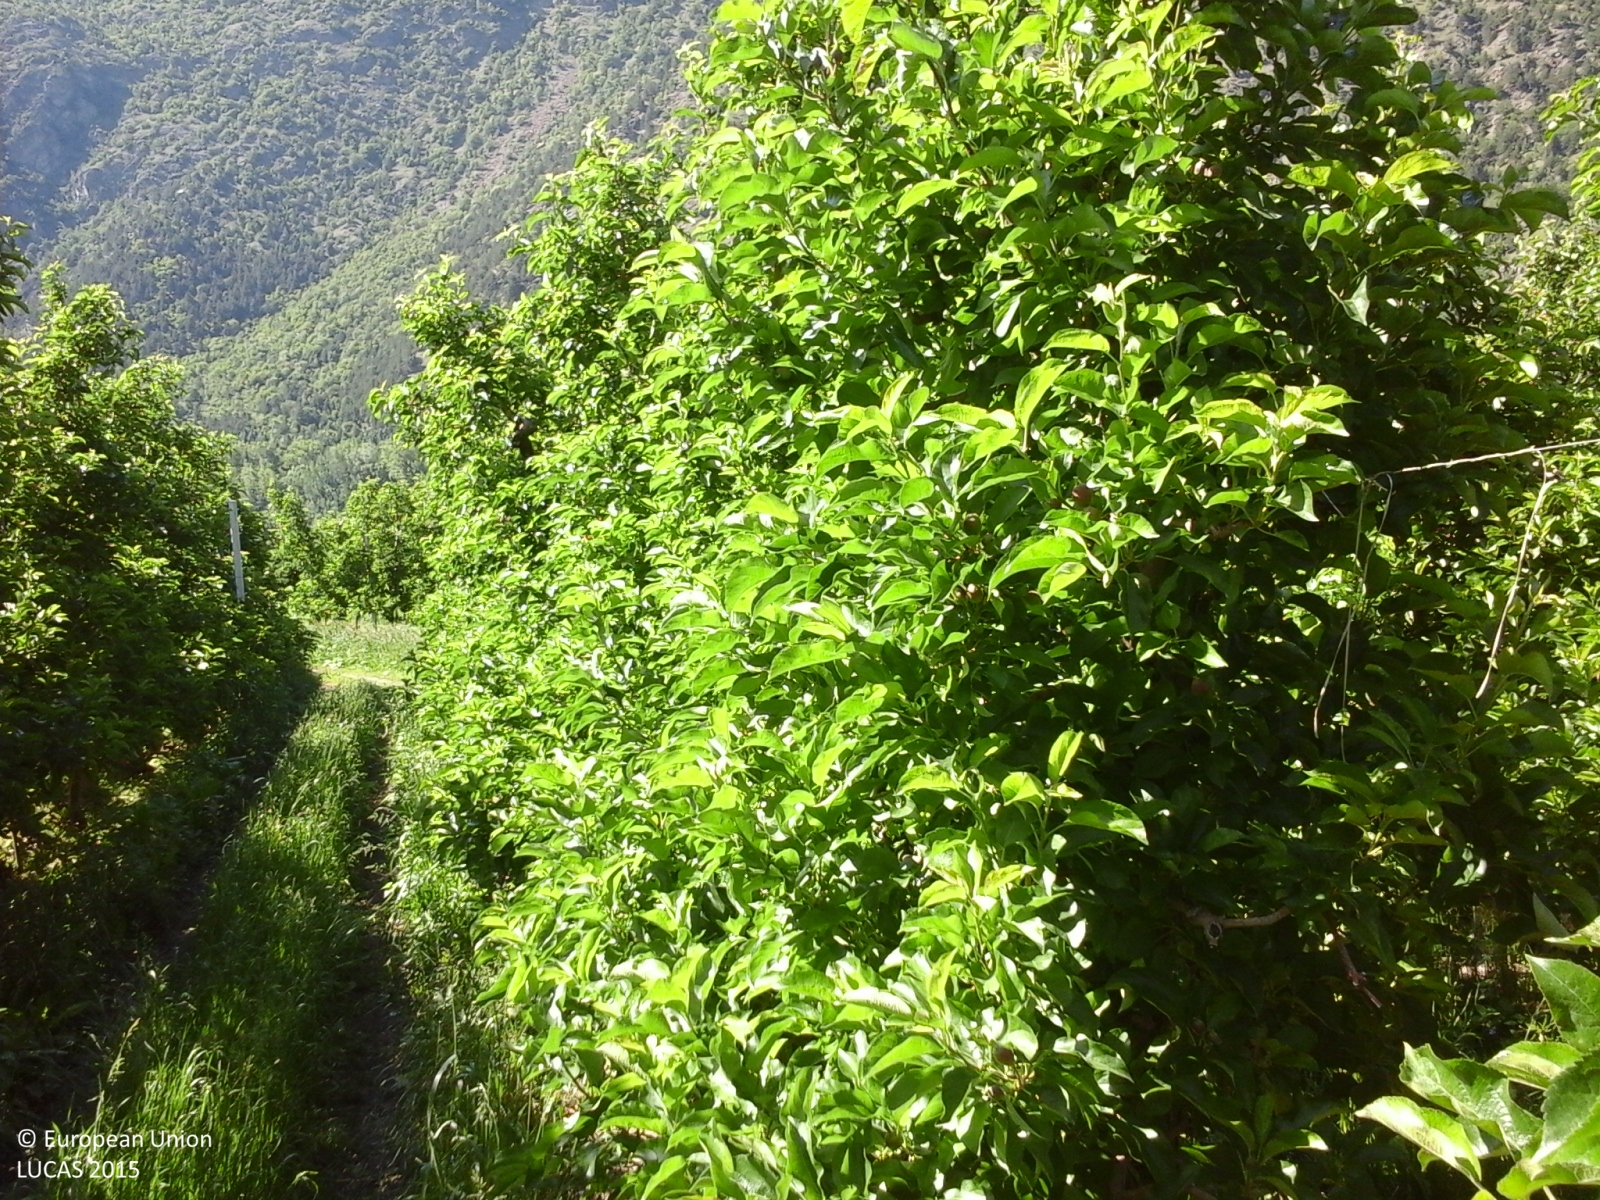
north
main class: Cropland
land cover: Apple fruit
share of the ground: > 75 %
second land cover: Grassland without tree/shrub cover
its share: > 75 %
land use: Agriculture (excluding fallow land and kitchen gardens)
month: May
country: IT
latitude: 46.6178
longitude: 10.8739
